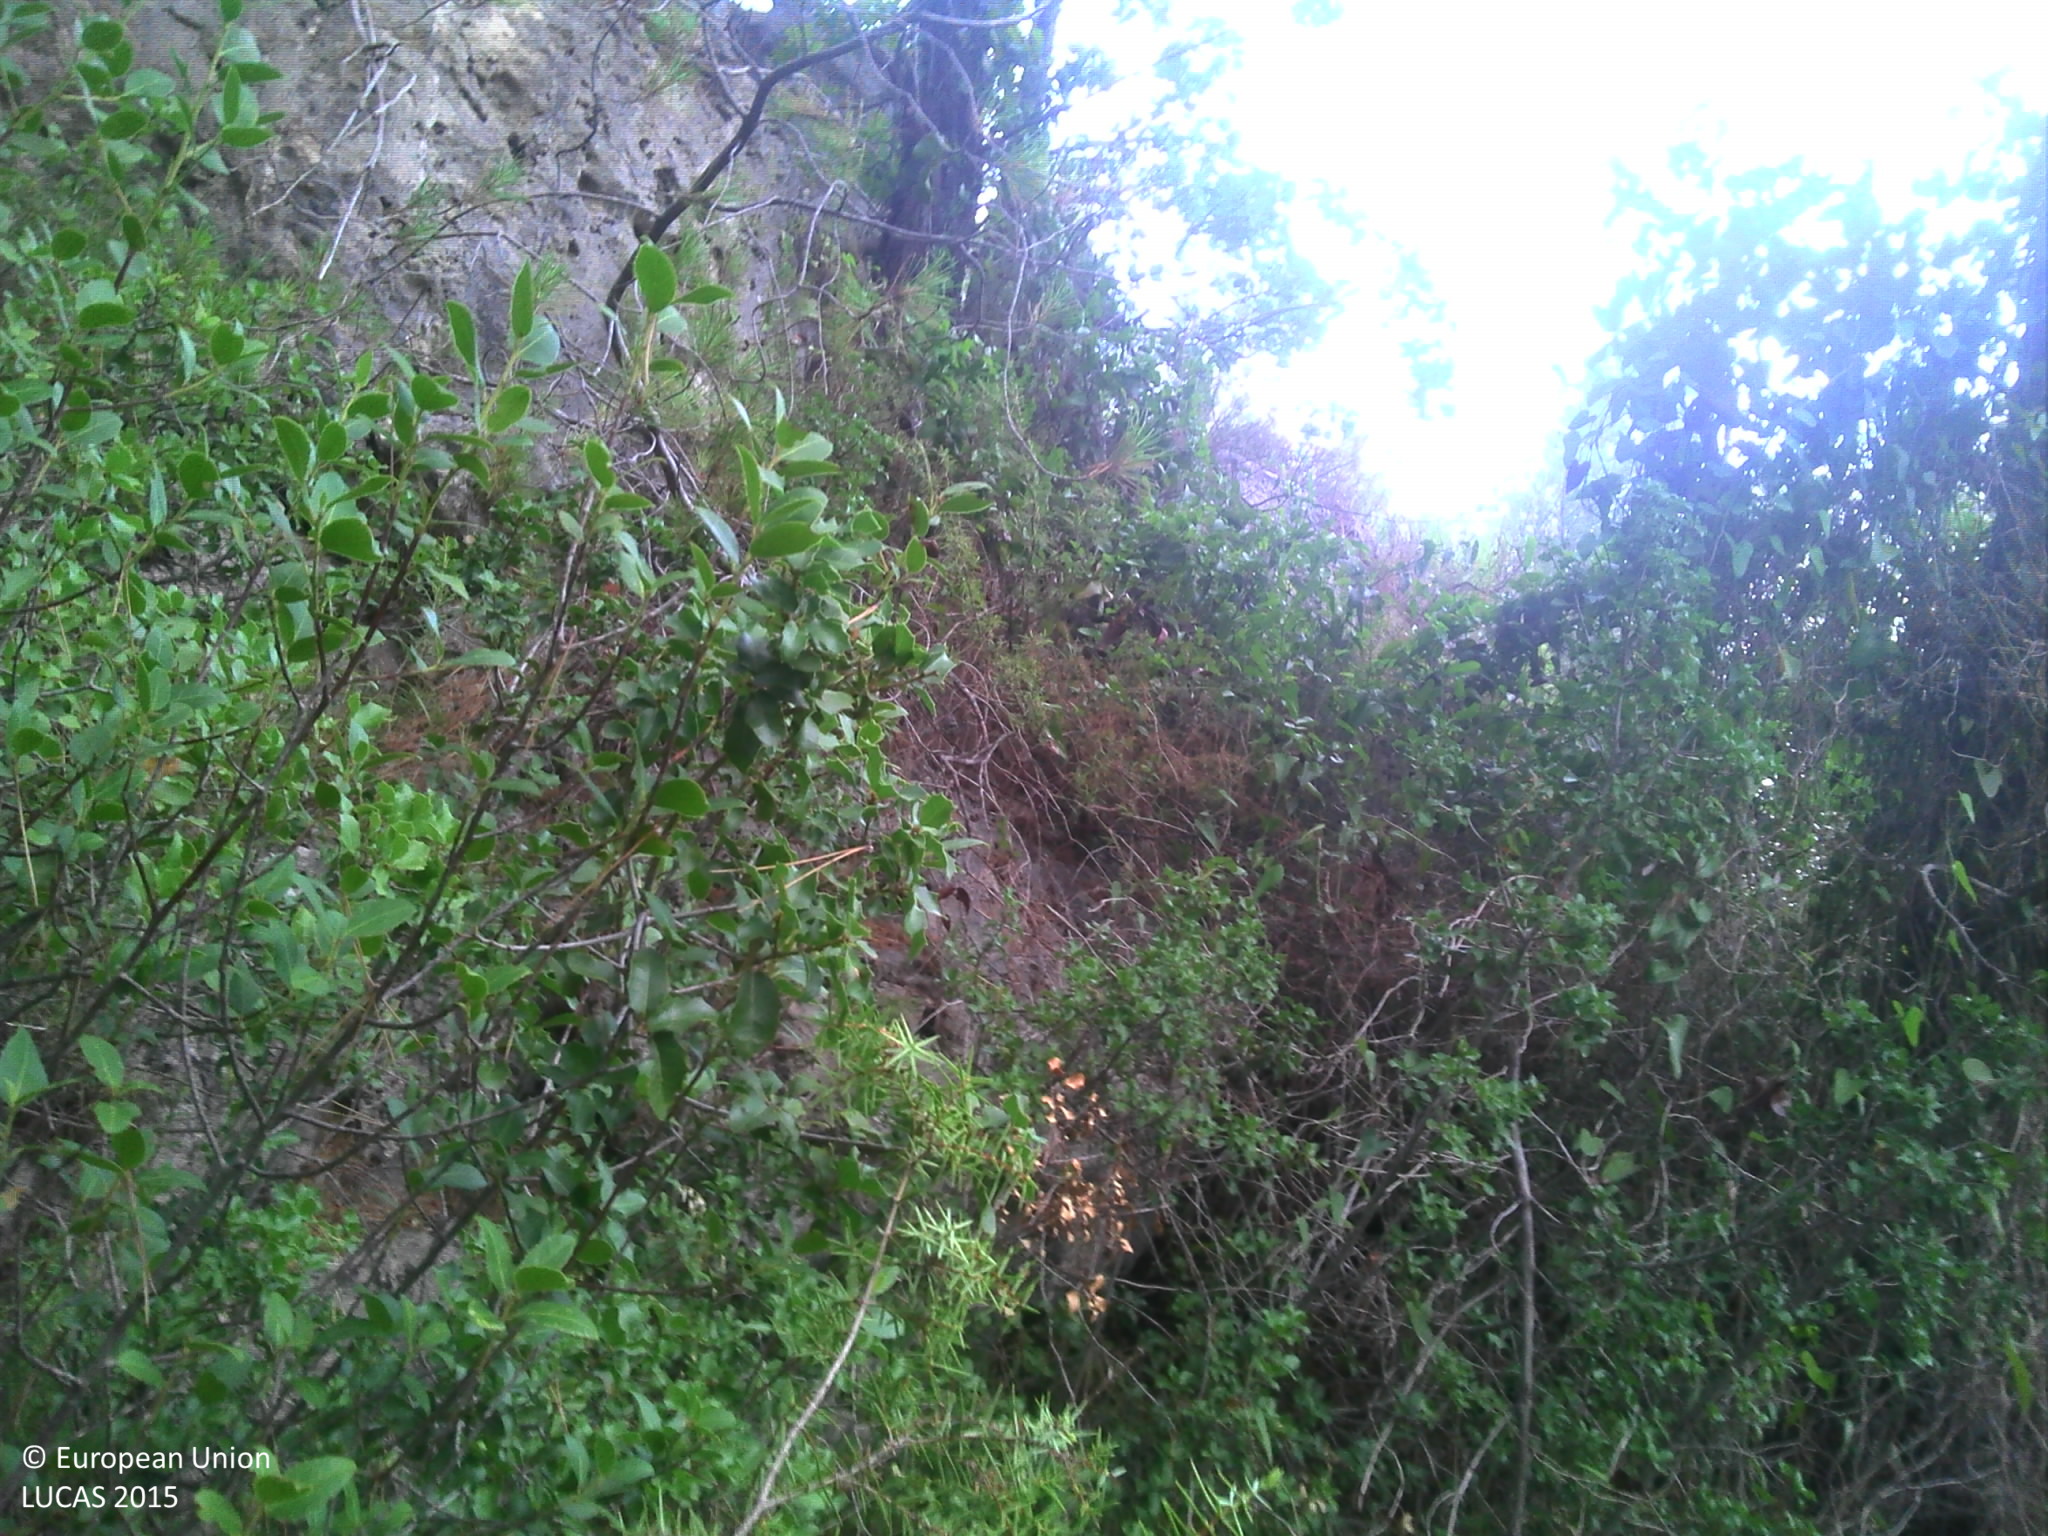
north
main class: Woodland
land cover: Pine dominated coniferous woodland
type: coniferous forest of the mediterranean region
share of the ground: > 75 %
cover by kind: coniferous forest trees 60 %, shrubs 20 %, unconsolidated bare surface 15 %, herbaceous plants 5 %
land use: Forestry
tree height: > 5 m
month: August
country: FR
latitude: 43.3563
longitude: 5.6546
